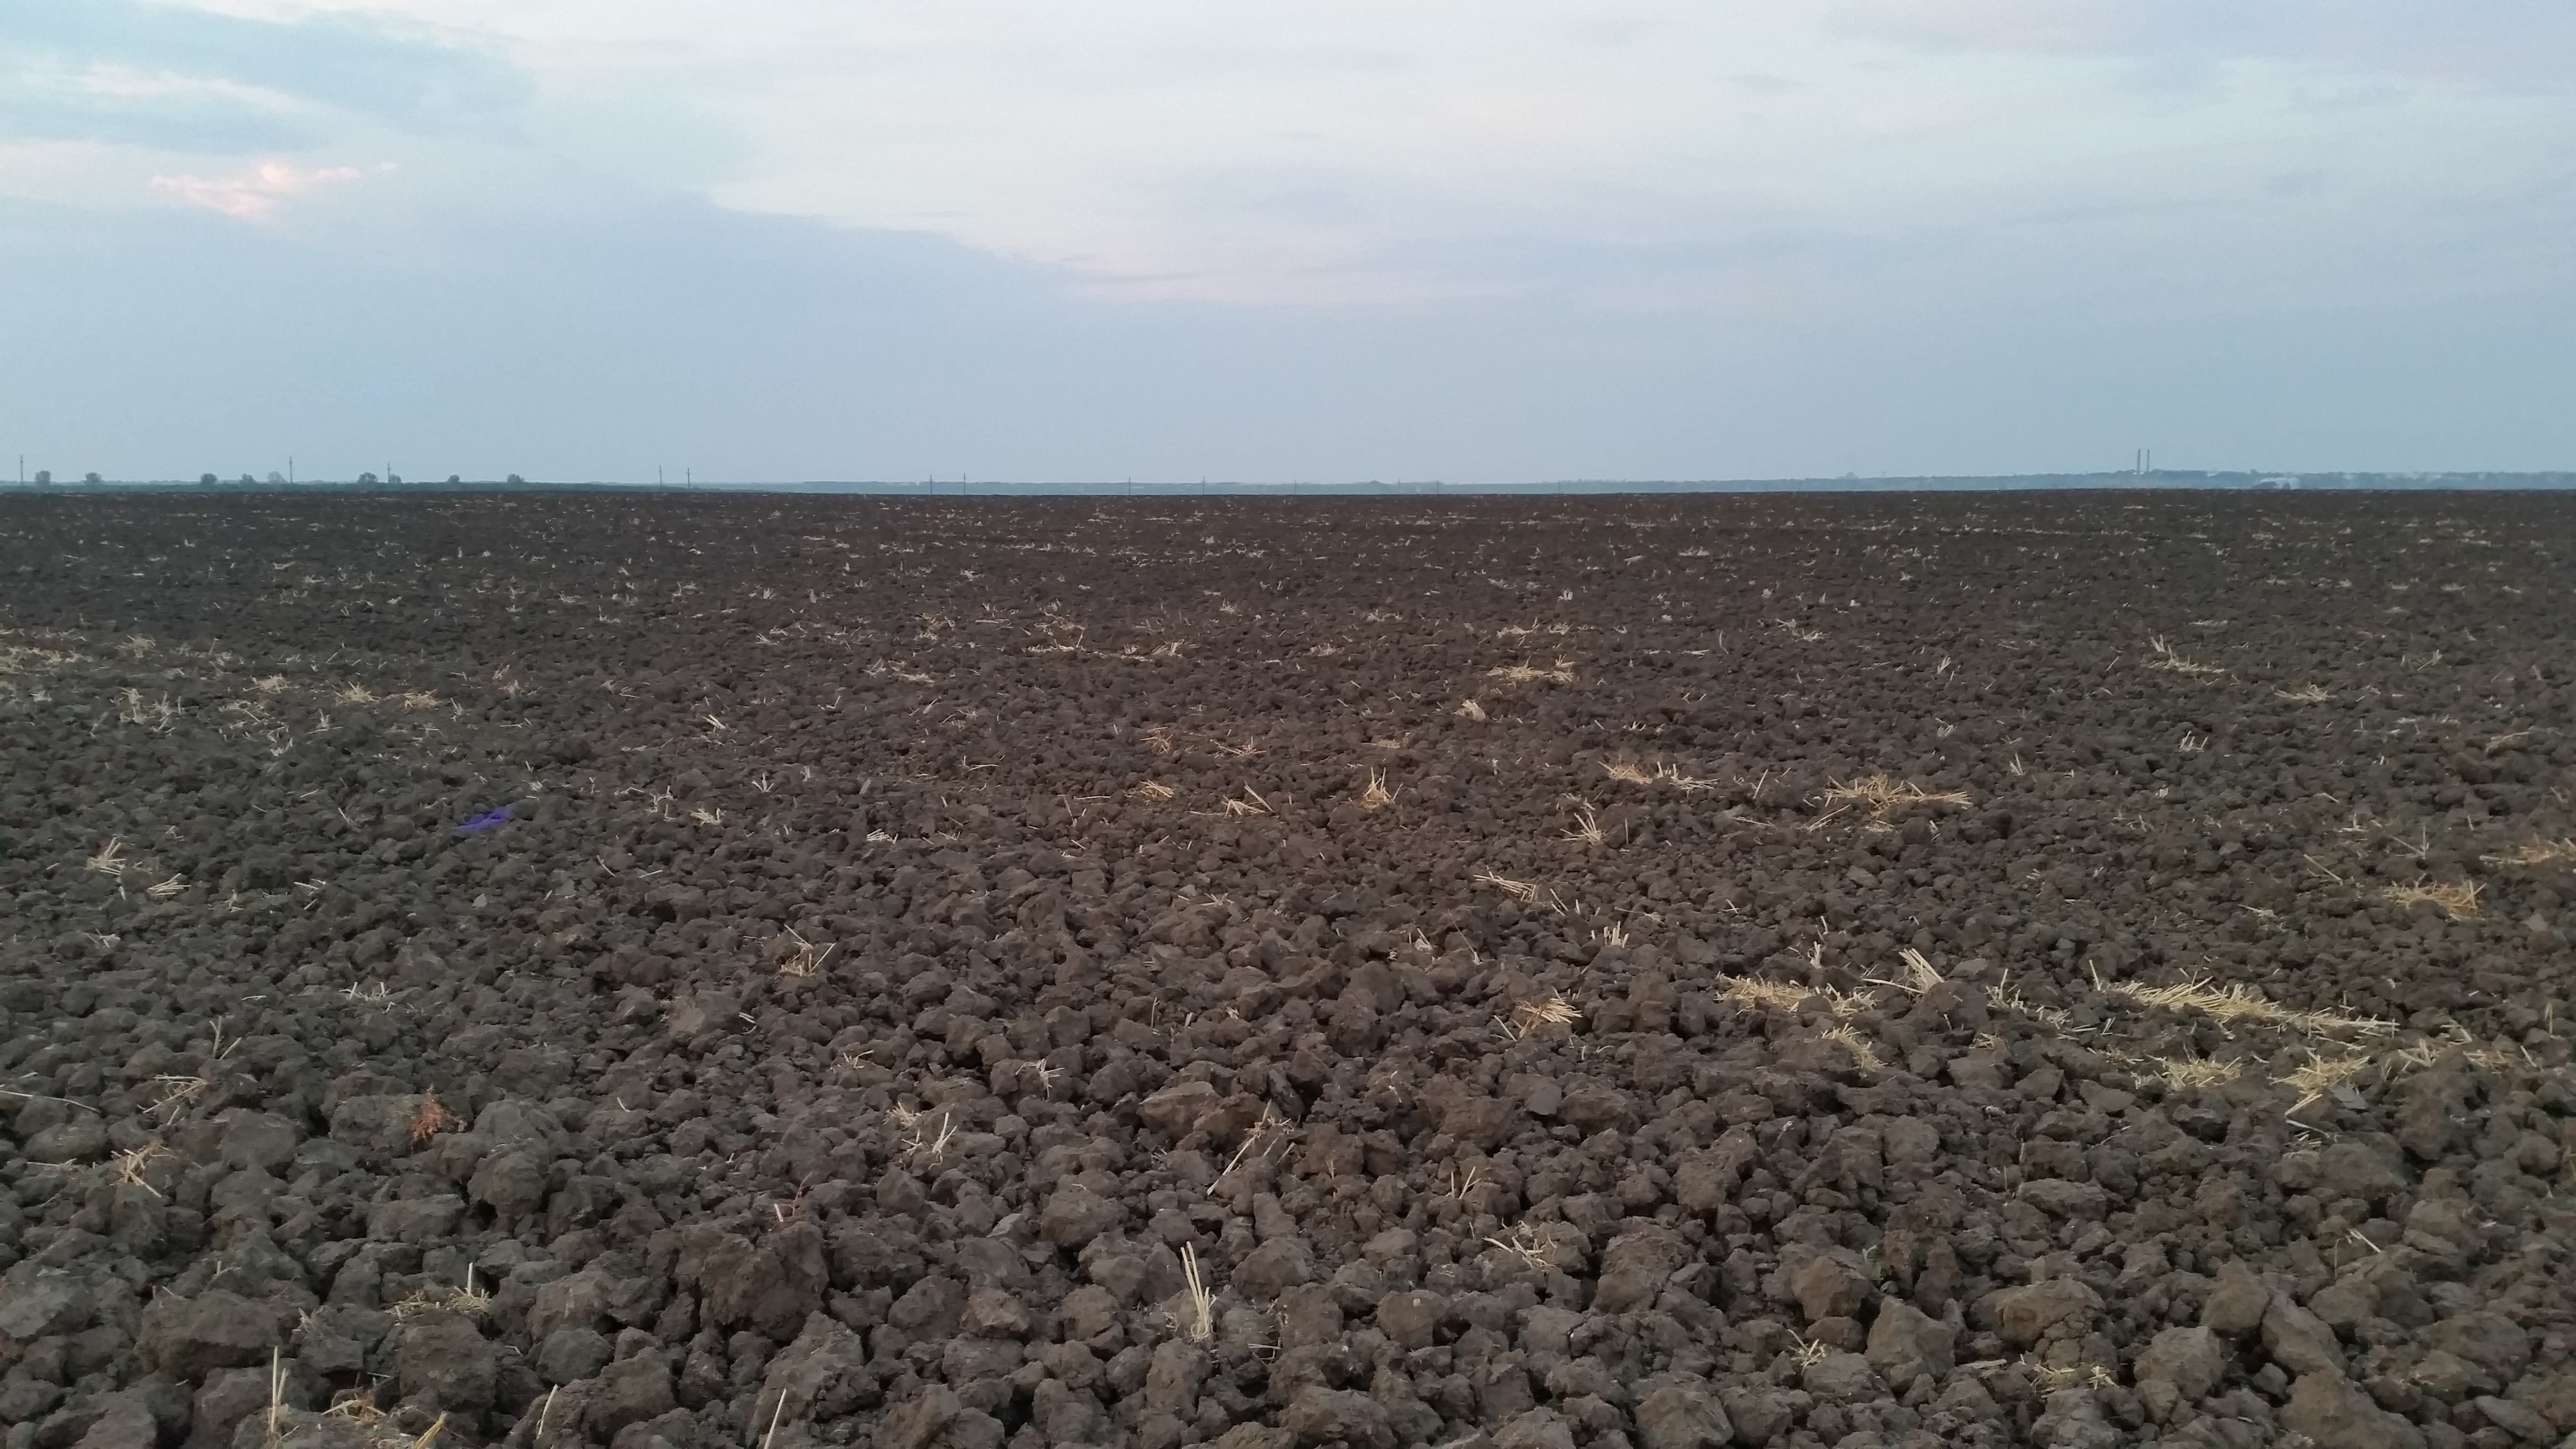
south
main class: Cropland
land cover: Common wheat
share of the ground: < 10 %
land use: Agriculture (excluding fallow land and kitchen gardens)
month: August
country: RO
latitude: 44.0587
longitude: 23.6969
